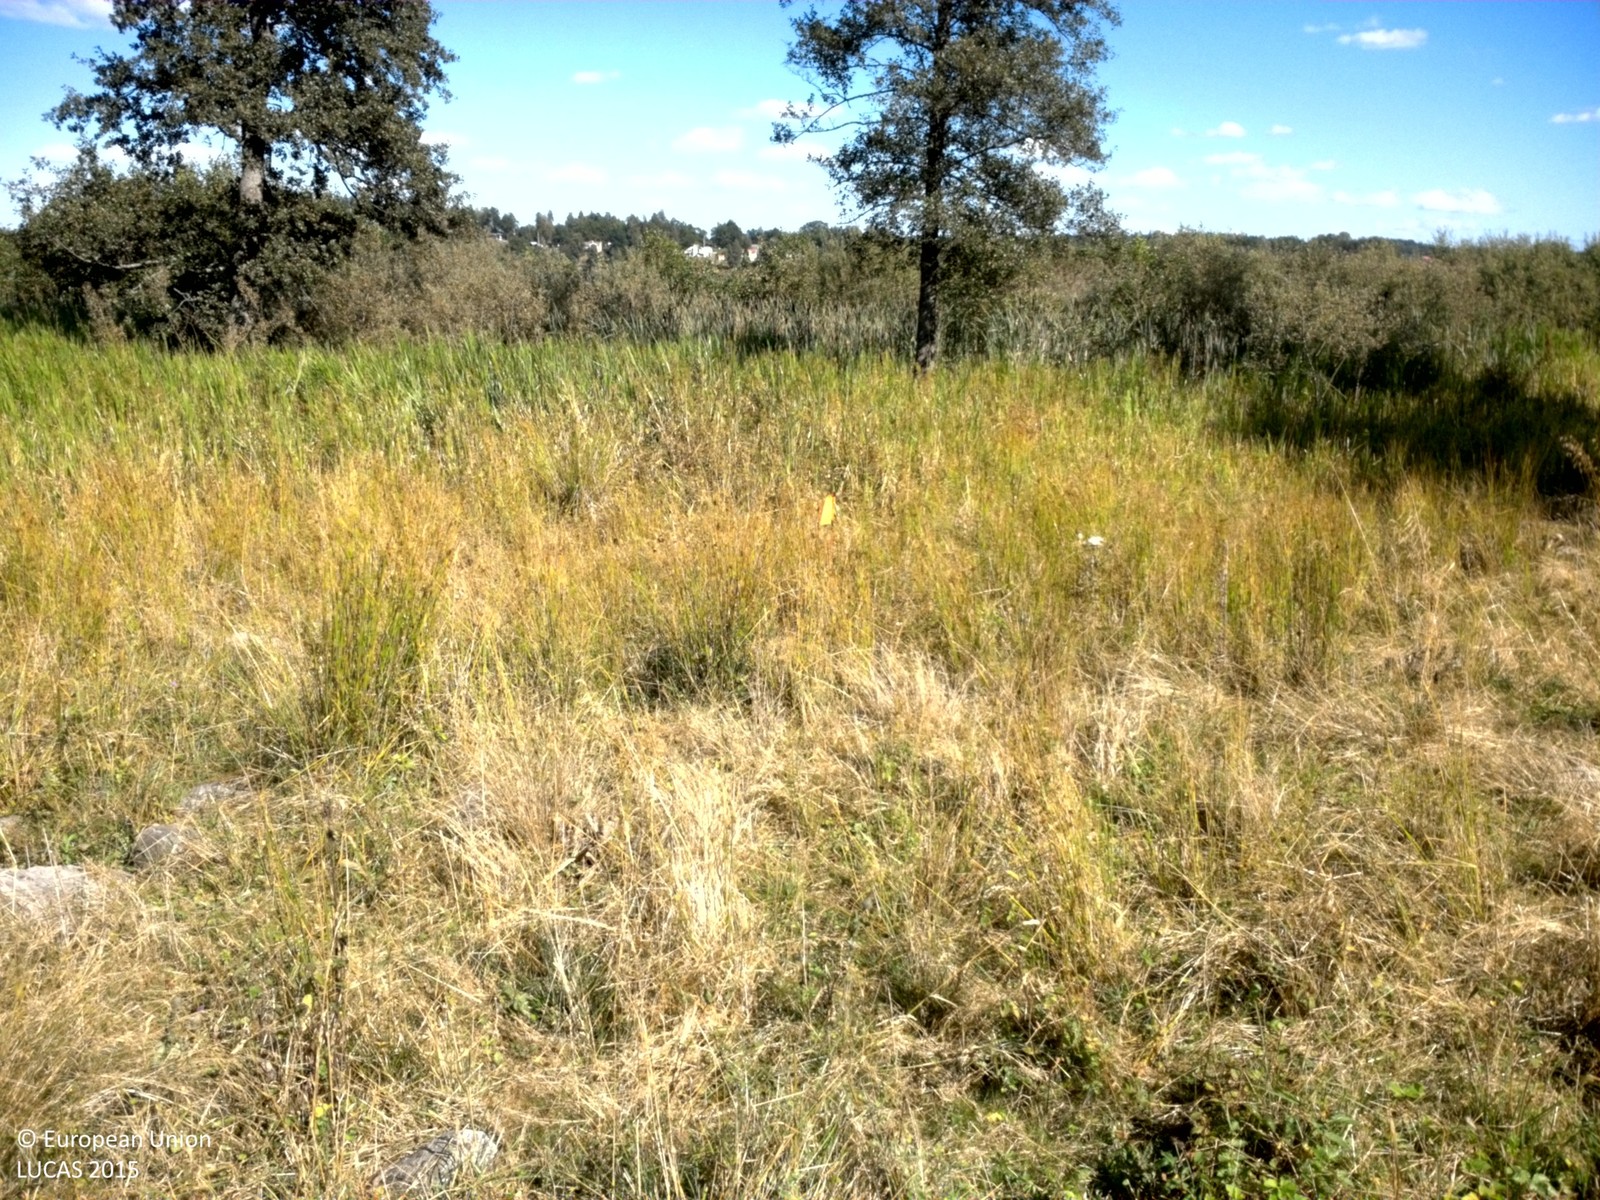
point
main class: Grassland
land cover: Grassland with sparse tree/shrub cover
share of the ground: > 75 %
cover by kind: herbaceous plants 95 %, broadleaved forest trees 5 %
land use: Agriculture (excluding fallow land and kitchen gardens)
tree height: > 5 m
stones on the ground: < 10 %
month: August
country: SE
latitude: 59.6515
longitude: 17.5717
